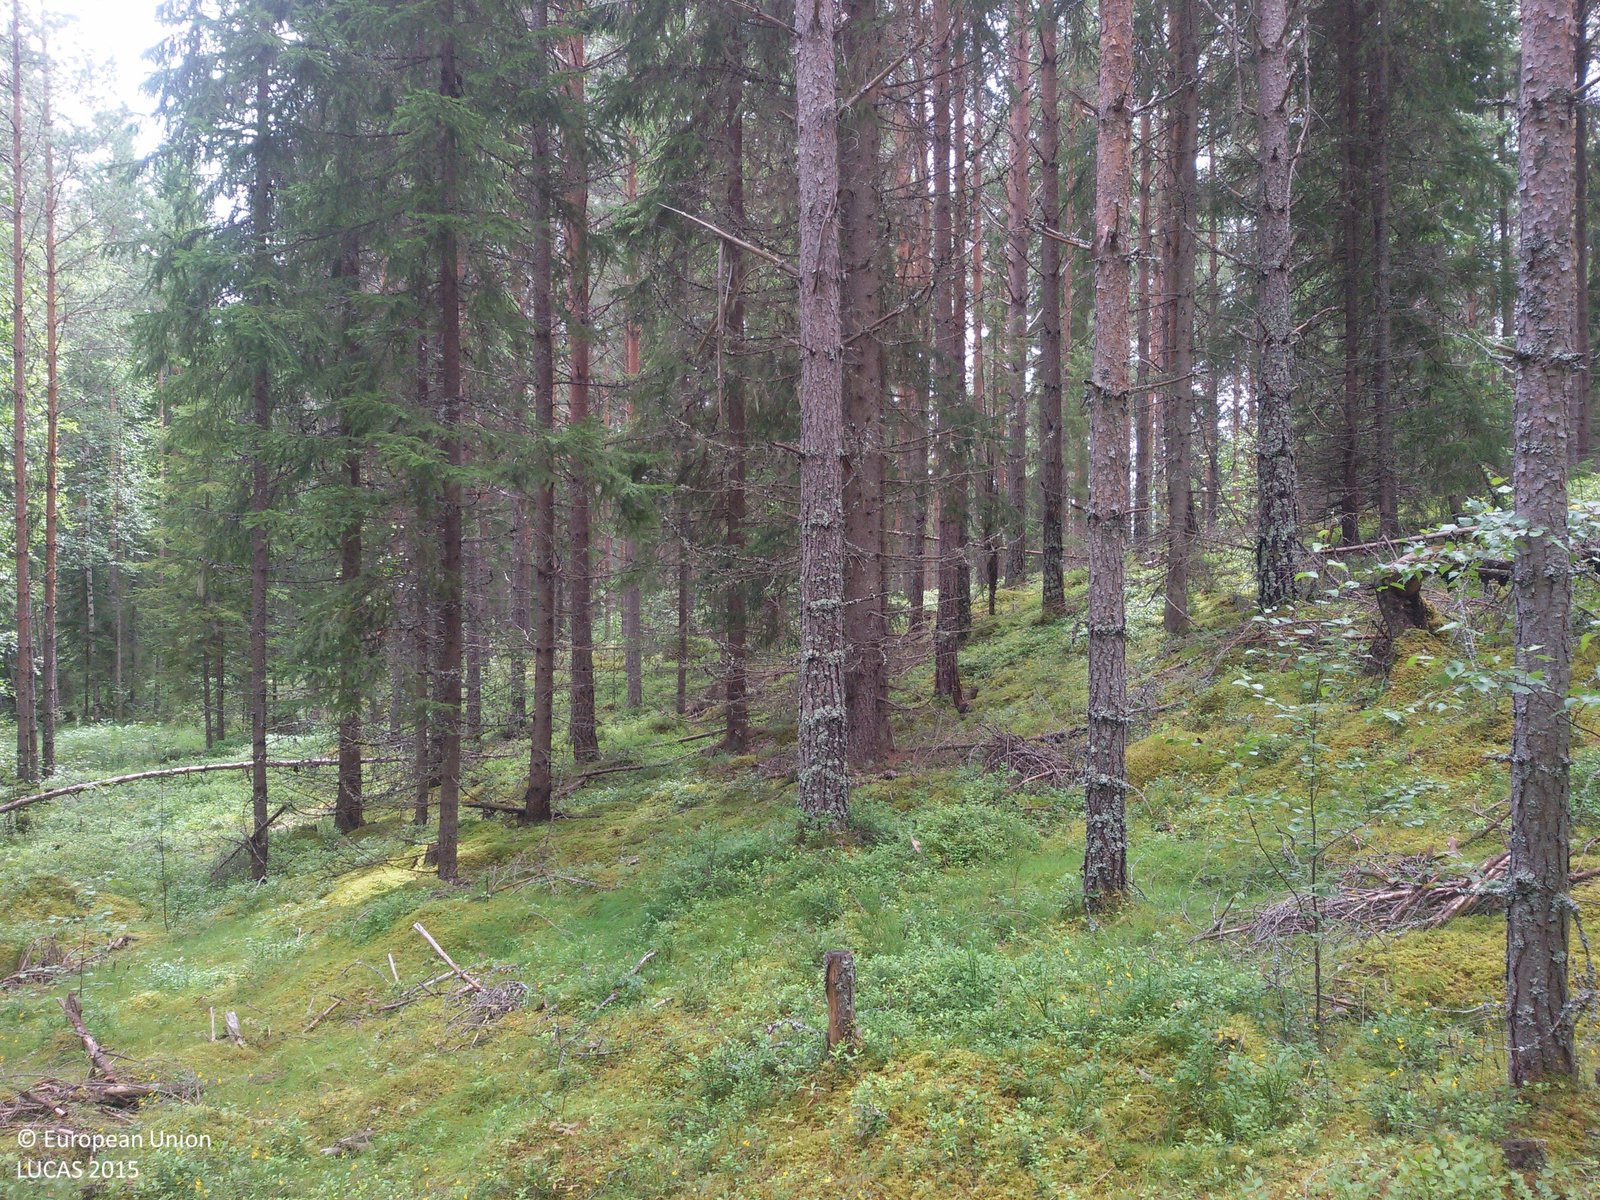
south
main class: Woodland
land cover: Pine dominated coniferous woodland
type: boreal forest
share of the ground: > 75 %
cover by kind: coniferous forest trees 75 %, shrubs 25 %
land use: Forestry
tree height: > 5 m
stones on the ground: > 50 %
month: July
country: SE
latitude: 60.4921
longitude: 15.8668
